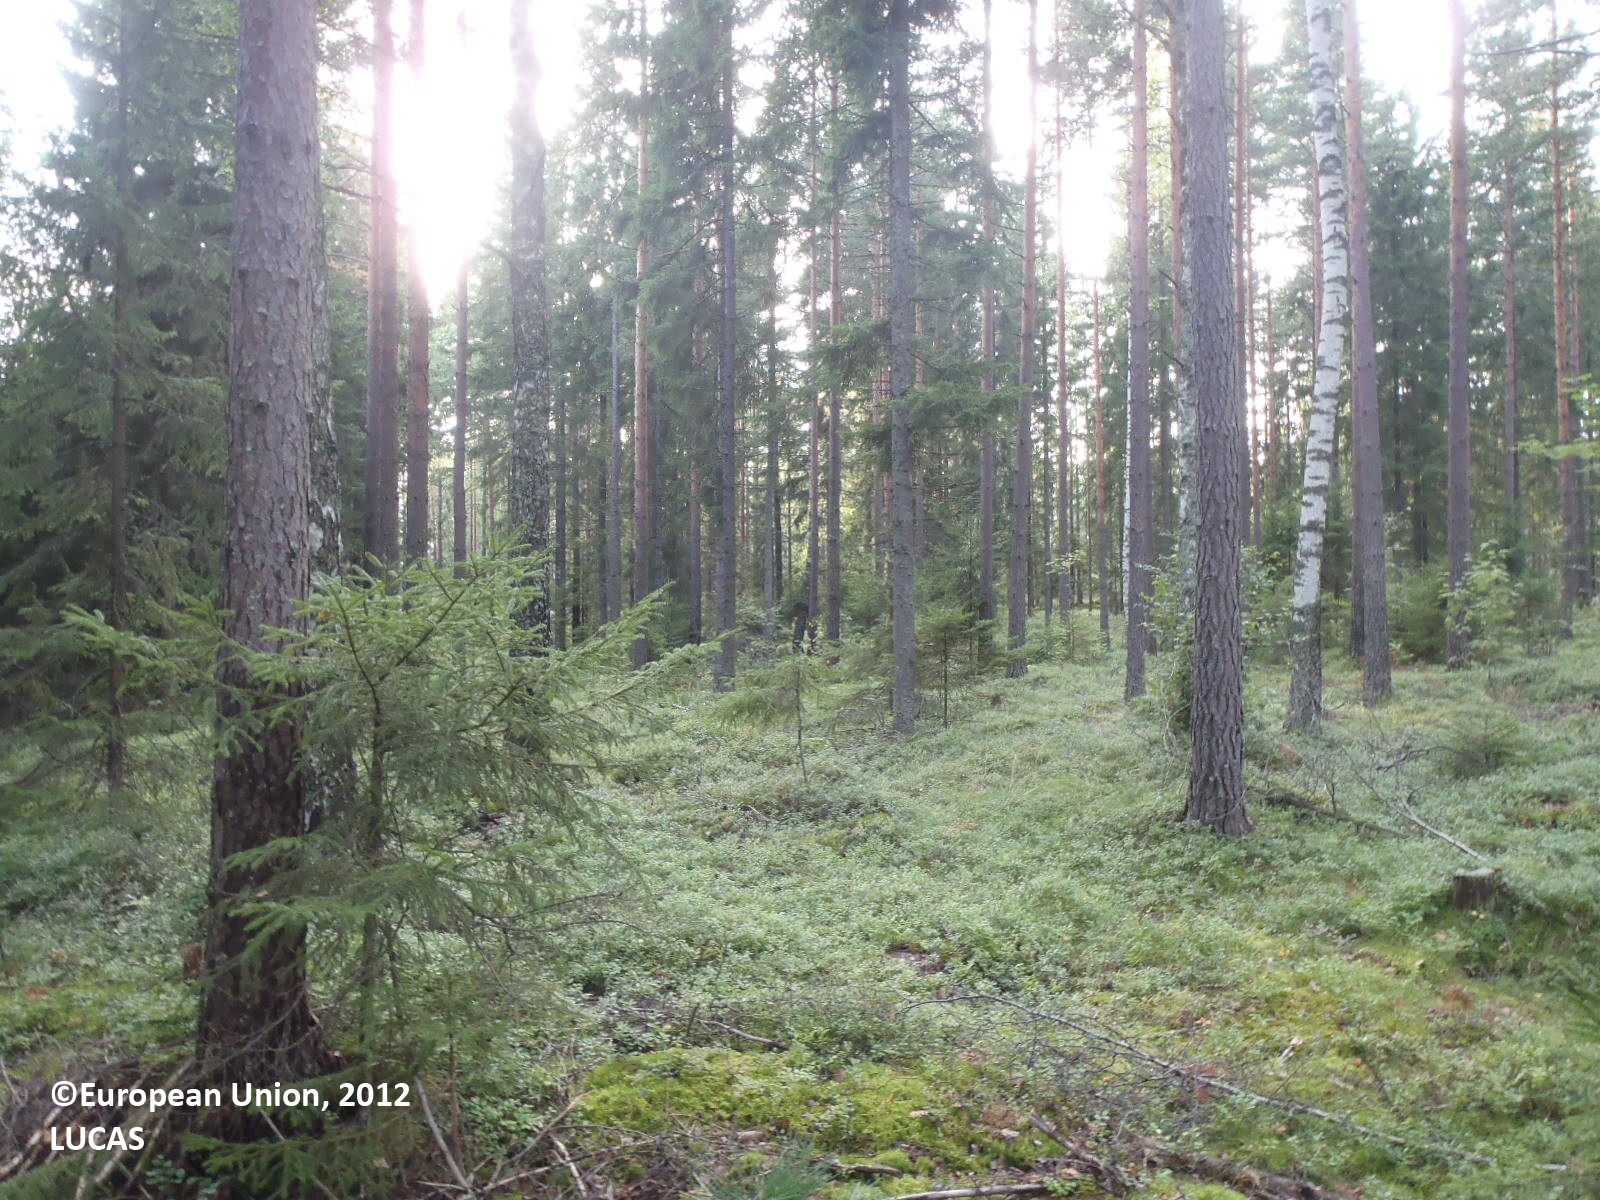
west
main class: Woodland
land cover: Pine dominated coniferous woodland
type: boreal forest
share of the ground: > 75 %
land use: Forestry
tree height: > 5 m
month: August
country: FI
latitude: 60.5738
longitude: 22.6812
